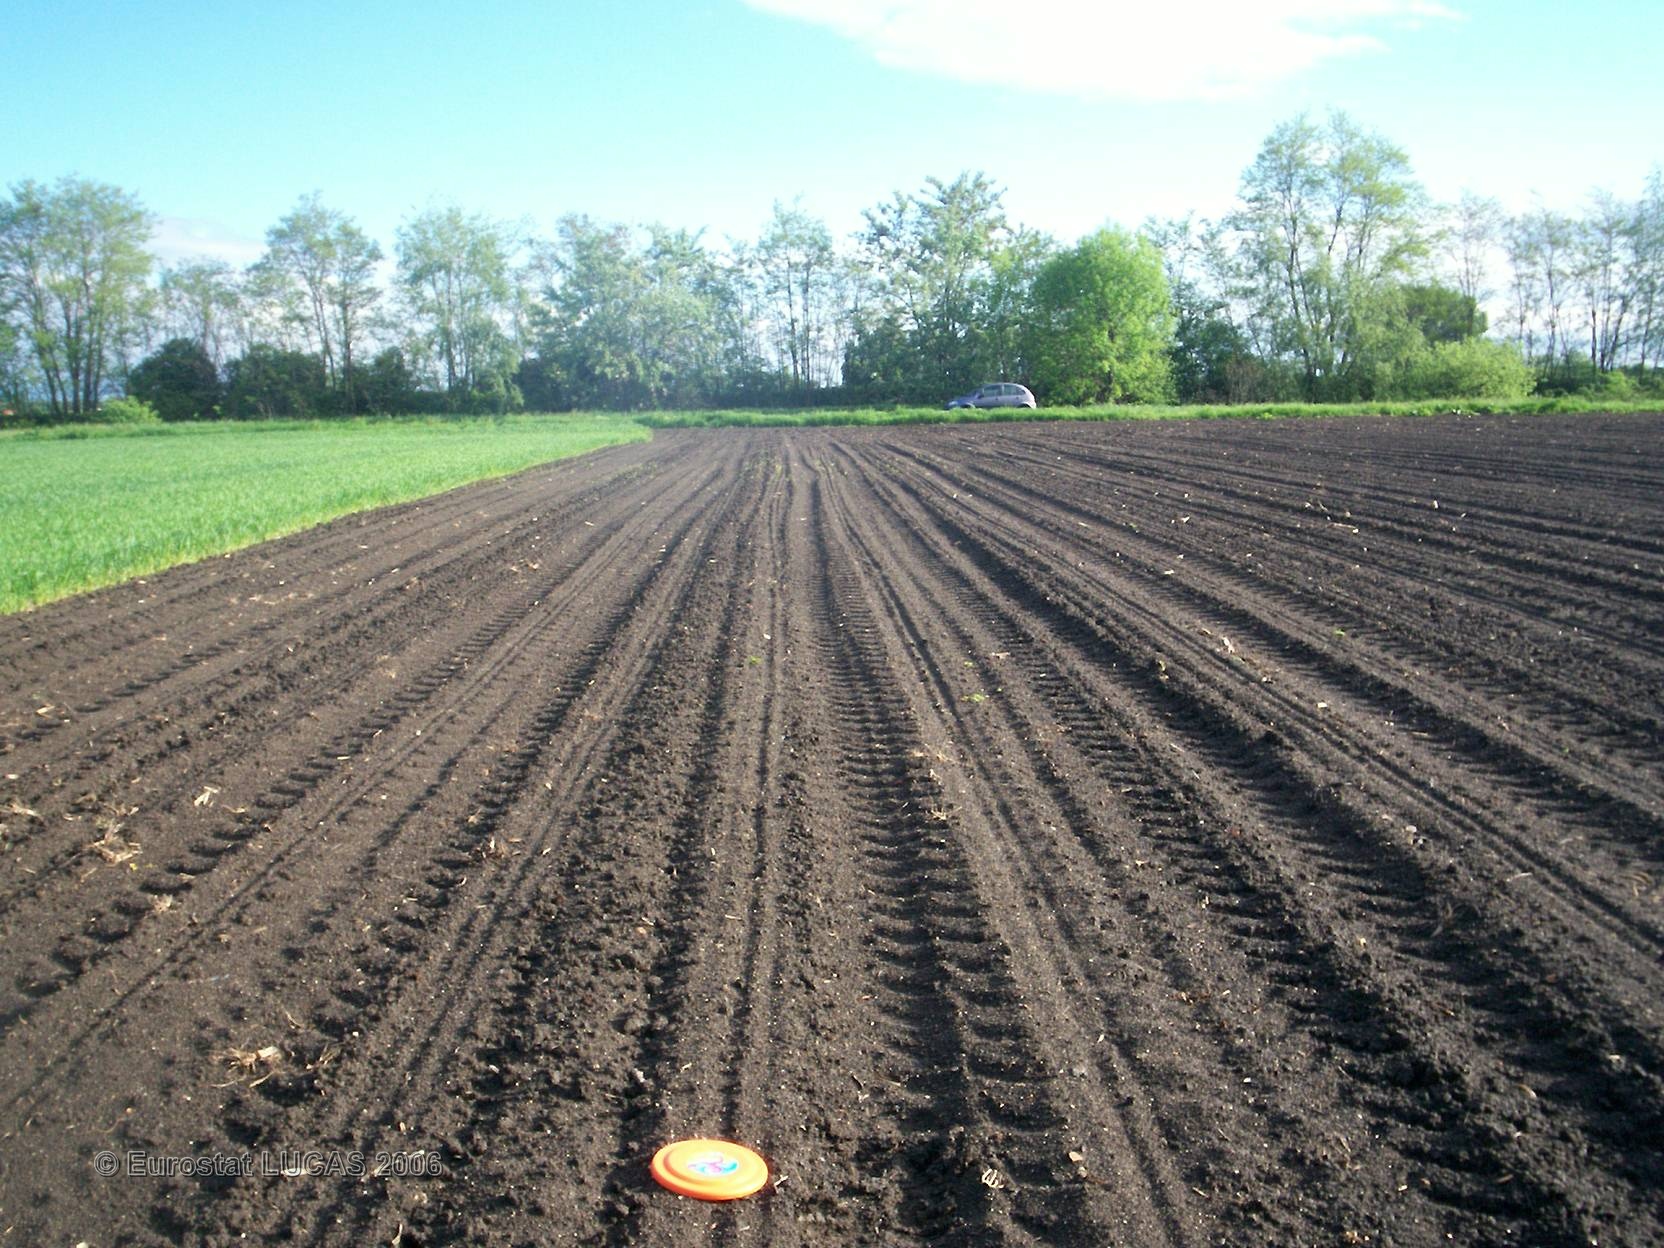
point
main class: Cropland
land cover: Maize
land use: Agriculture (excluding fallow land and kitchen gardens)
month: May
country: FR
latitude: 45.8252
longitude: 3.1648
